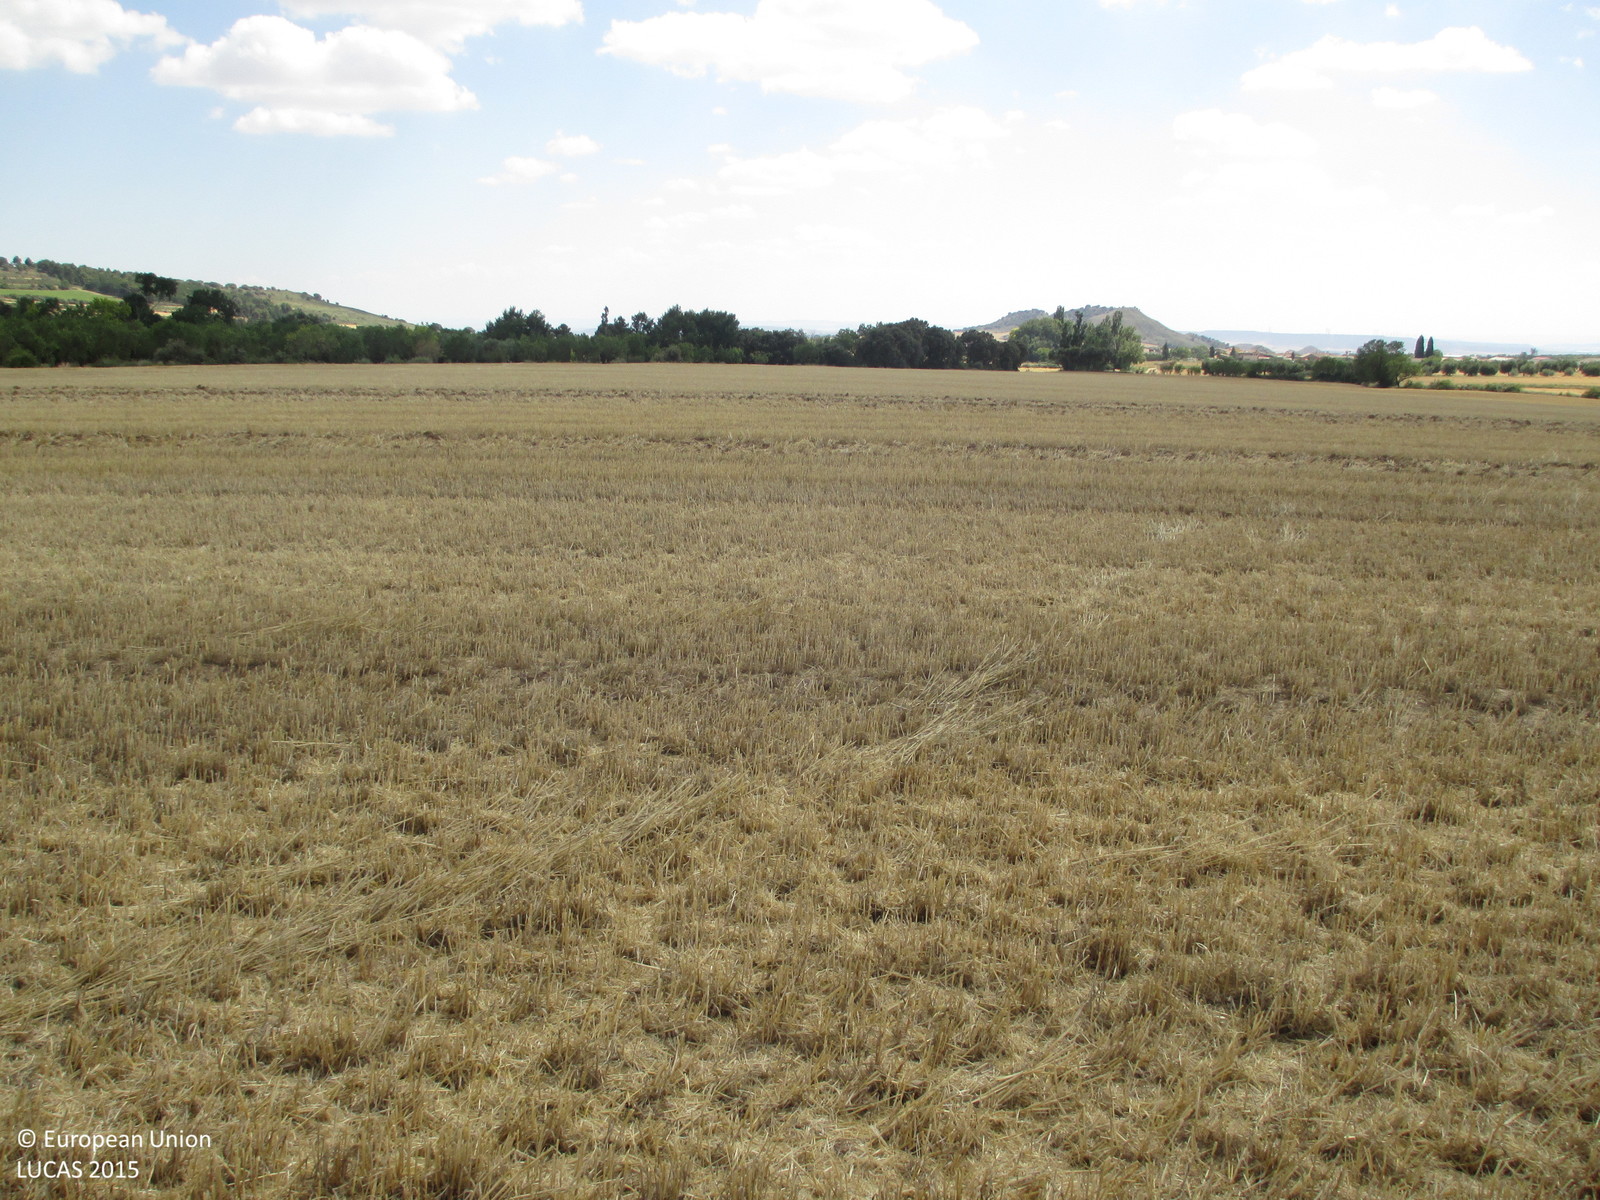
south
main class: Cropland
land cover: Barley
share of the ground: < 10 %
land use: Agriculture (excluding fallow land and kitchen gardens)
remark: Harvested field
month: June
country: ES
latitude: 42.2540
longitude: -0.4846
